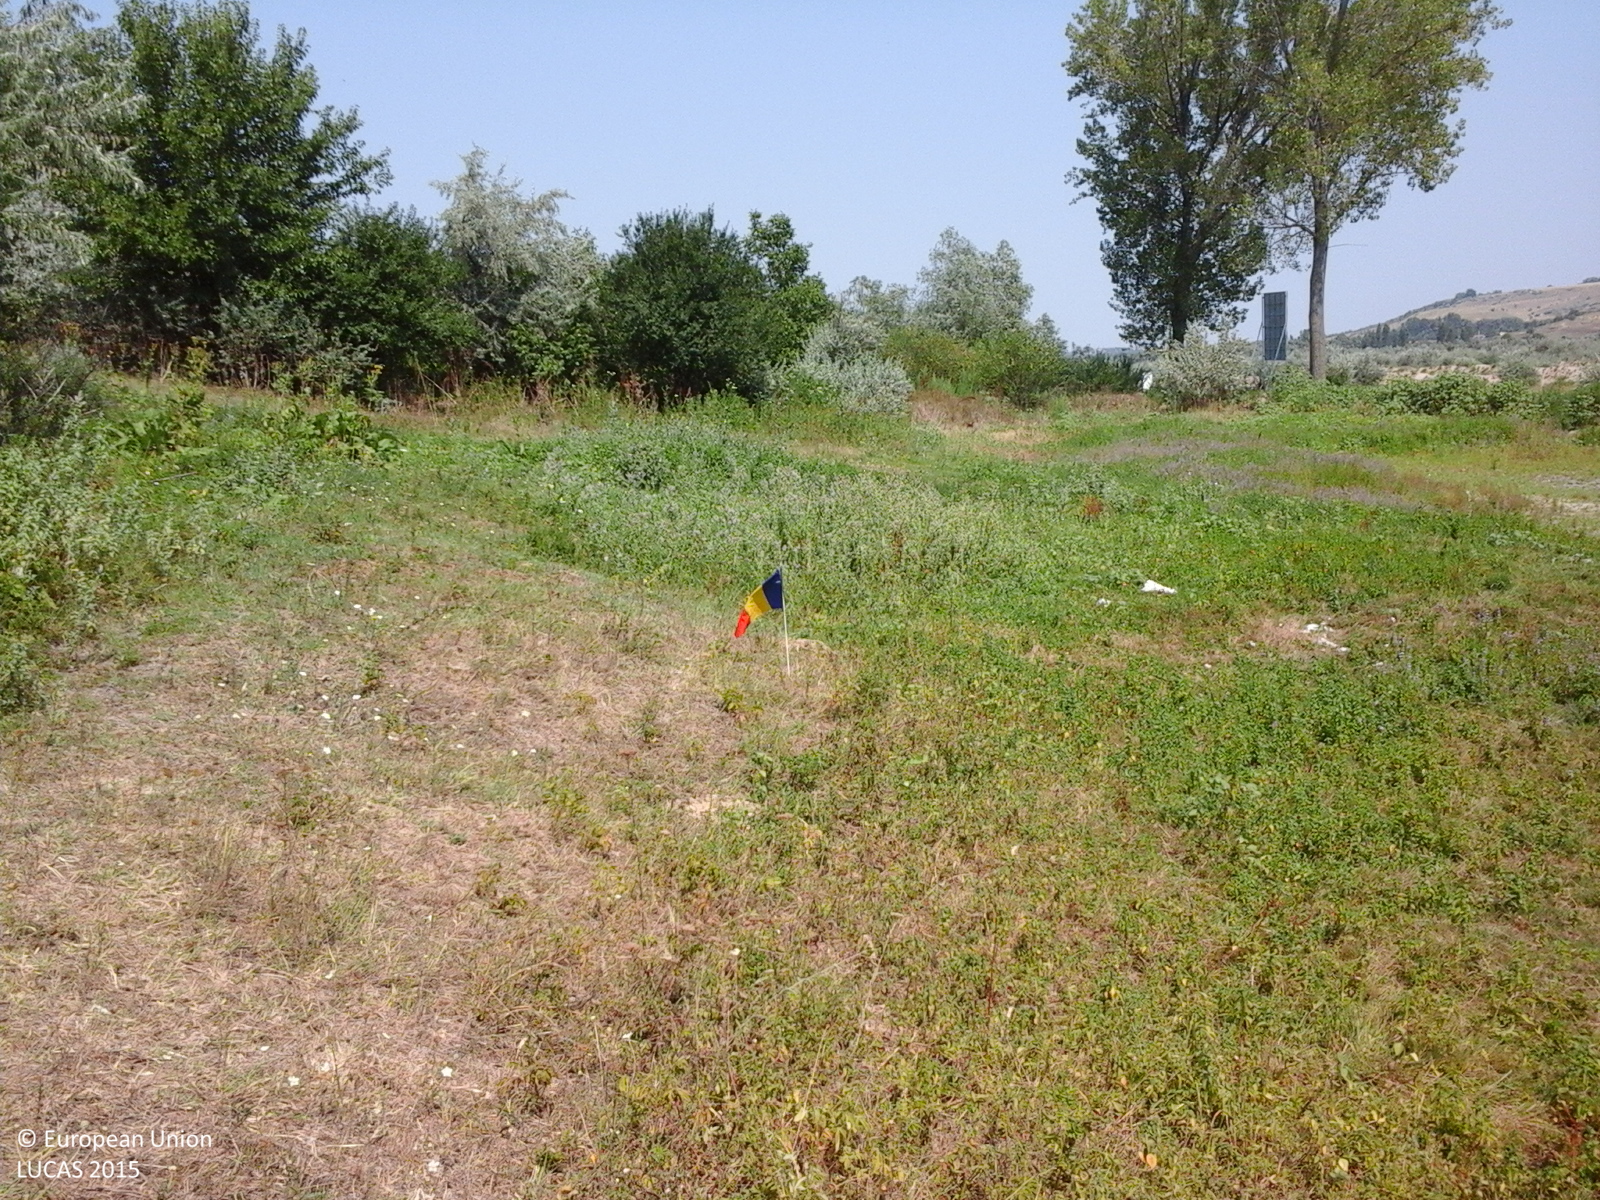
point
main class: Grassland
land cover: Grassland without tree/shrub cover
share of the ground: > 75 %
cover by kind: herbaceous plants 100 %
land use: Agriculture (excluding fallow land and kitchen gardens)
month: July
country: RO
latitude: 45.8350
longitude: 27.9234
